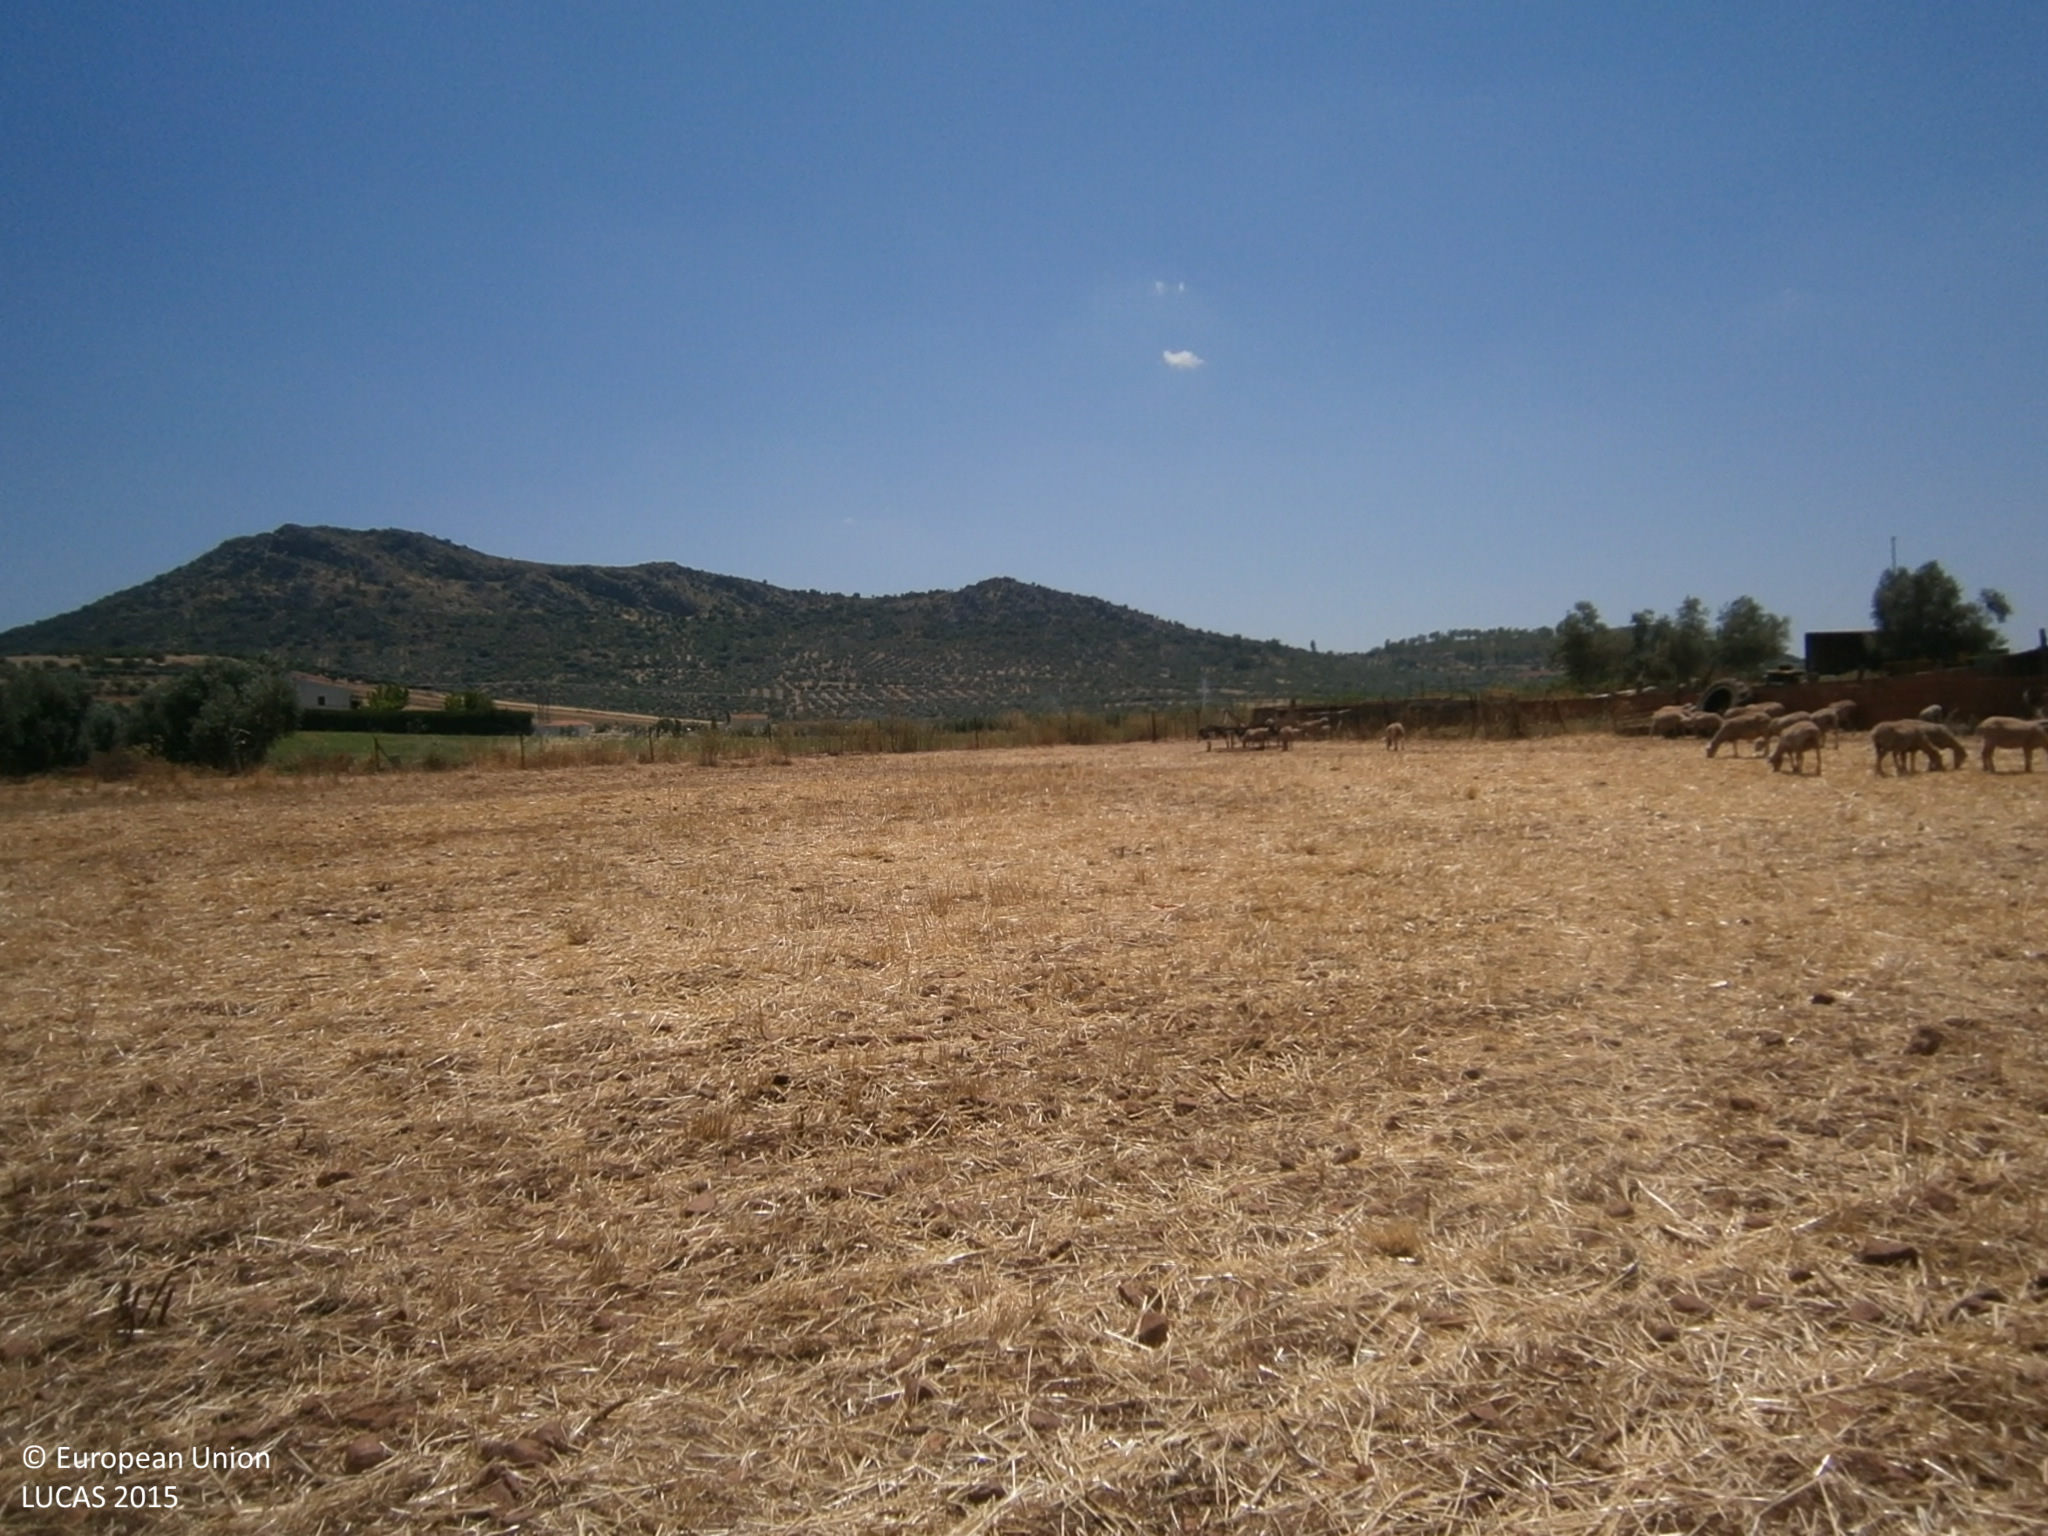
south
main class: Cropland
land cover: Temporary grasslands
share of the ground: > 75 %
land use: Agriculture (excluding fallow land and kitchen gardens)
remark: Harvested field
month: June
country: ES
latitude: 38.8129
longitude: -6.2343
